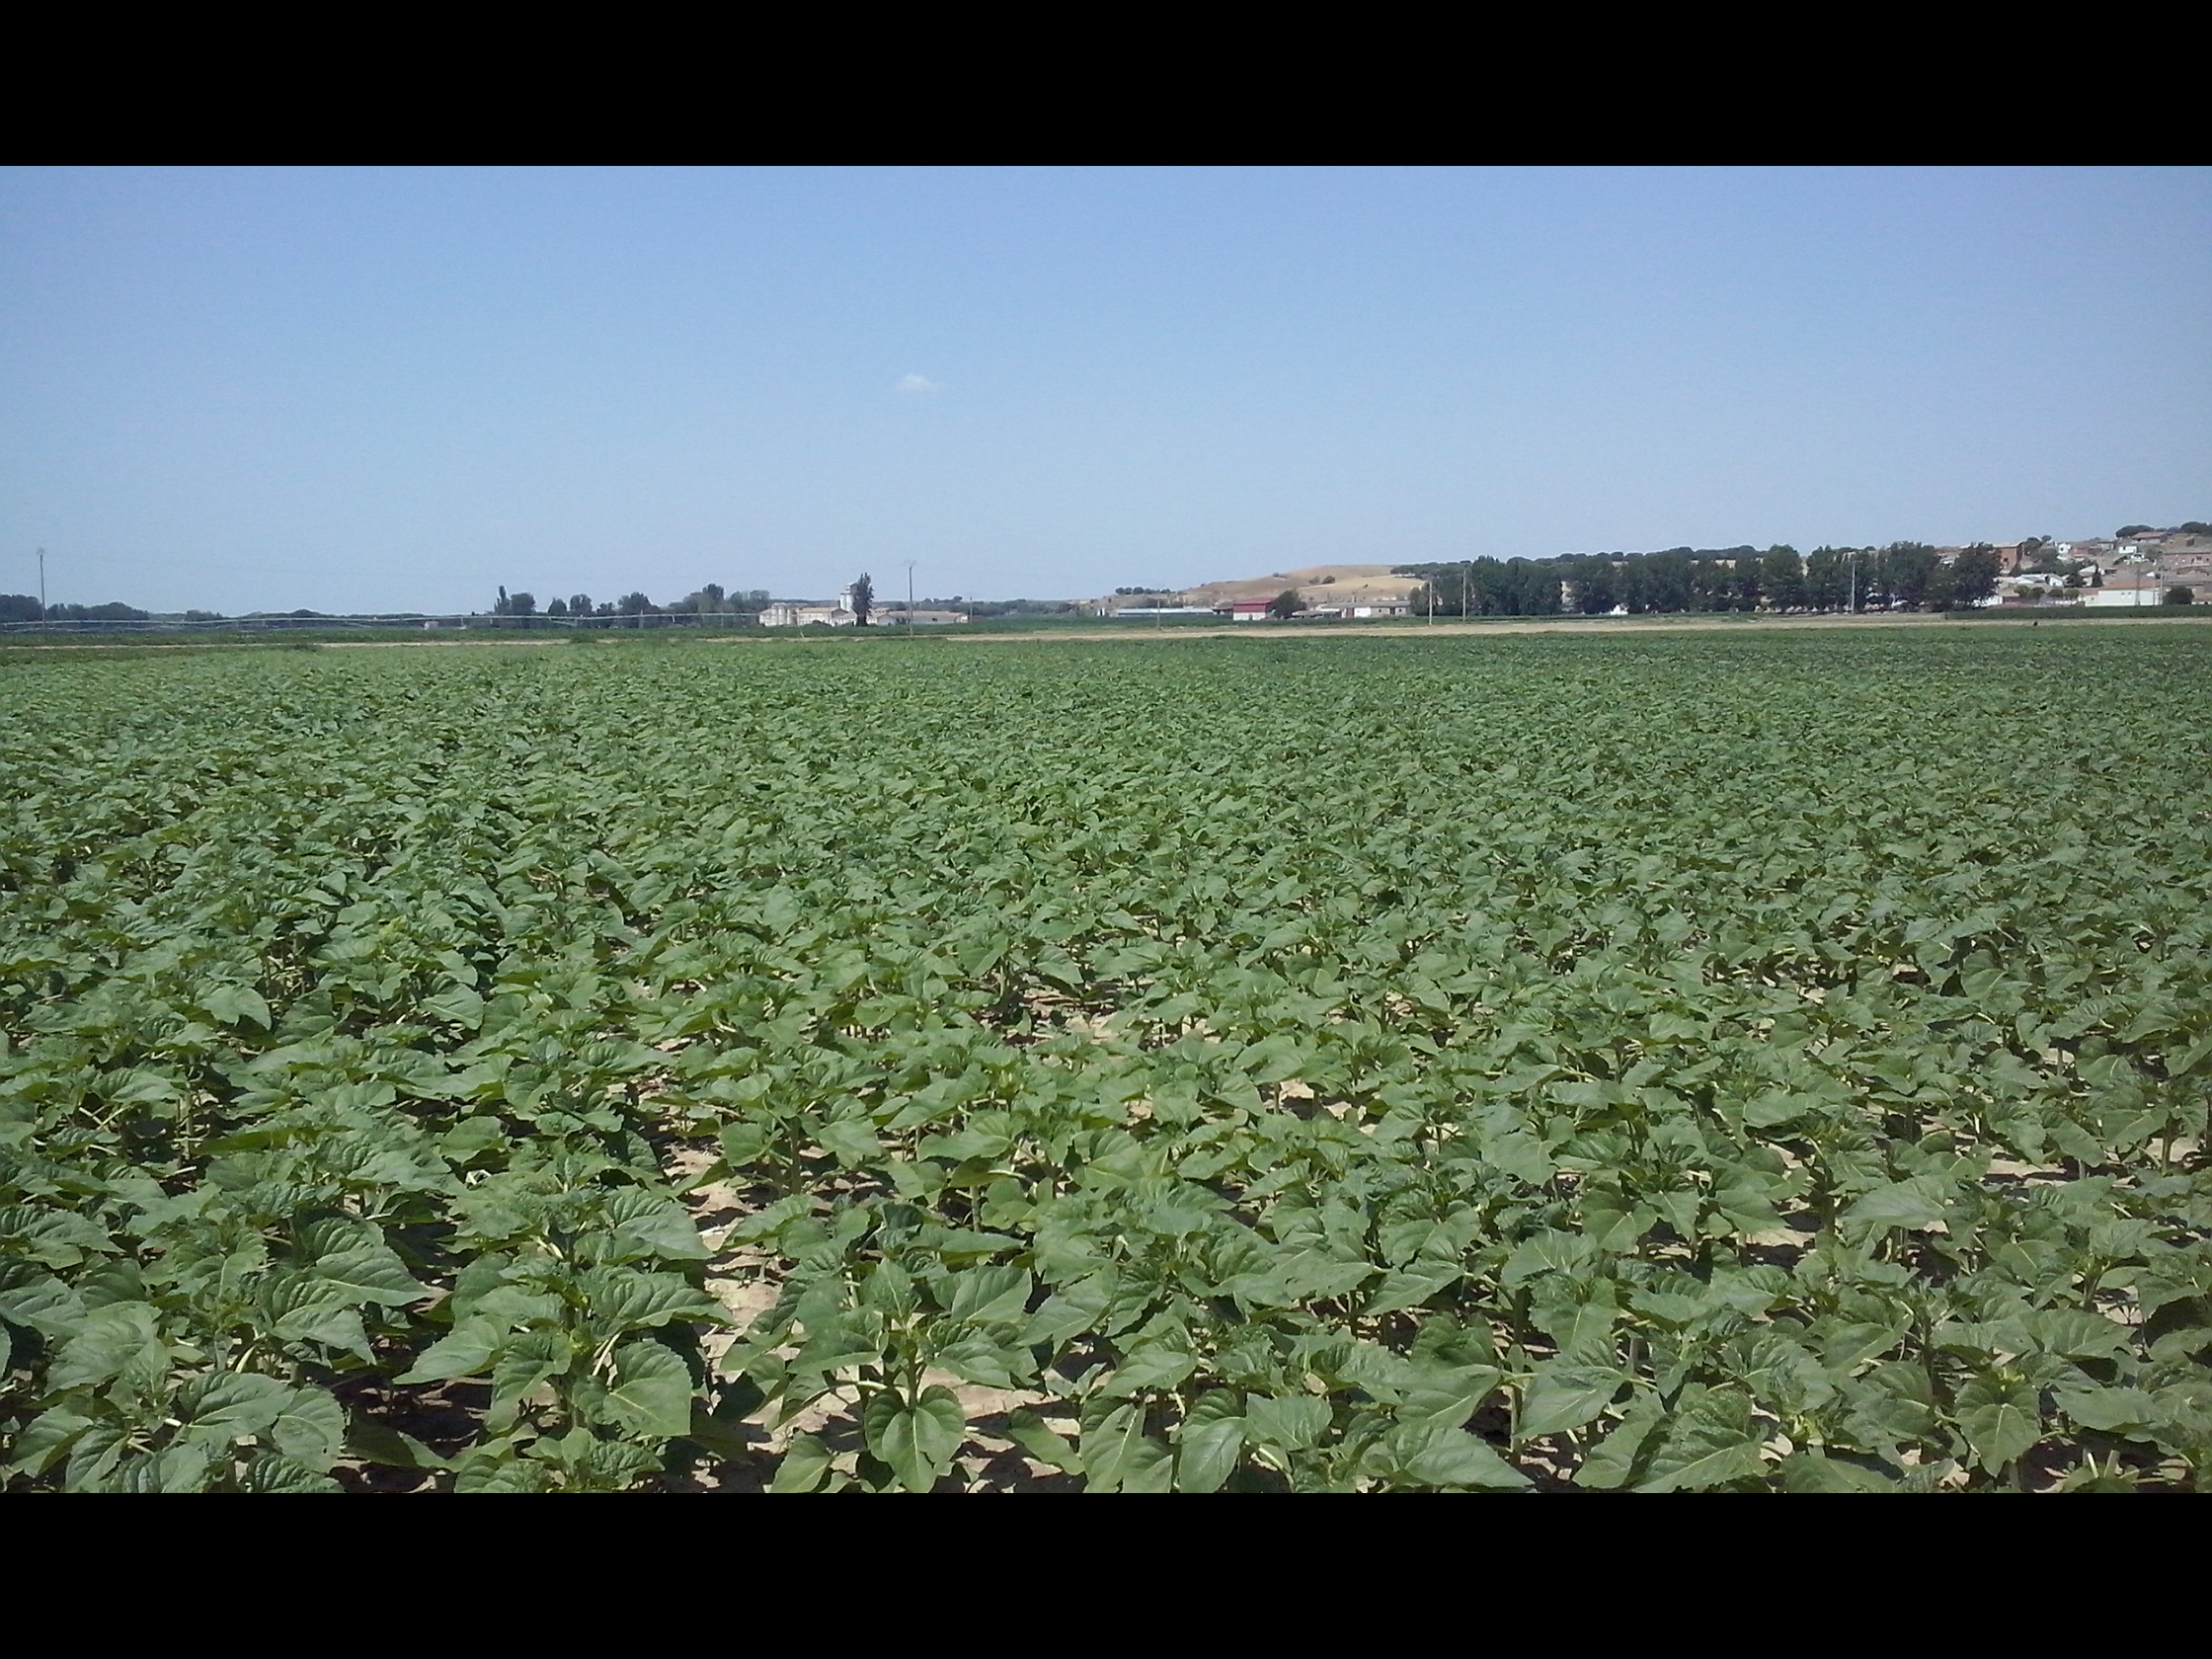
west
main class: Cropland
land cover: Sunflower
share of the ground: > 75 %
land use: Agriculture (excluding fallow land and kitchen gardens)
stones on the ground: < 10 %
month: June
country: ES
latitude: 41.4809
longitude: -5.0791
